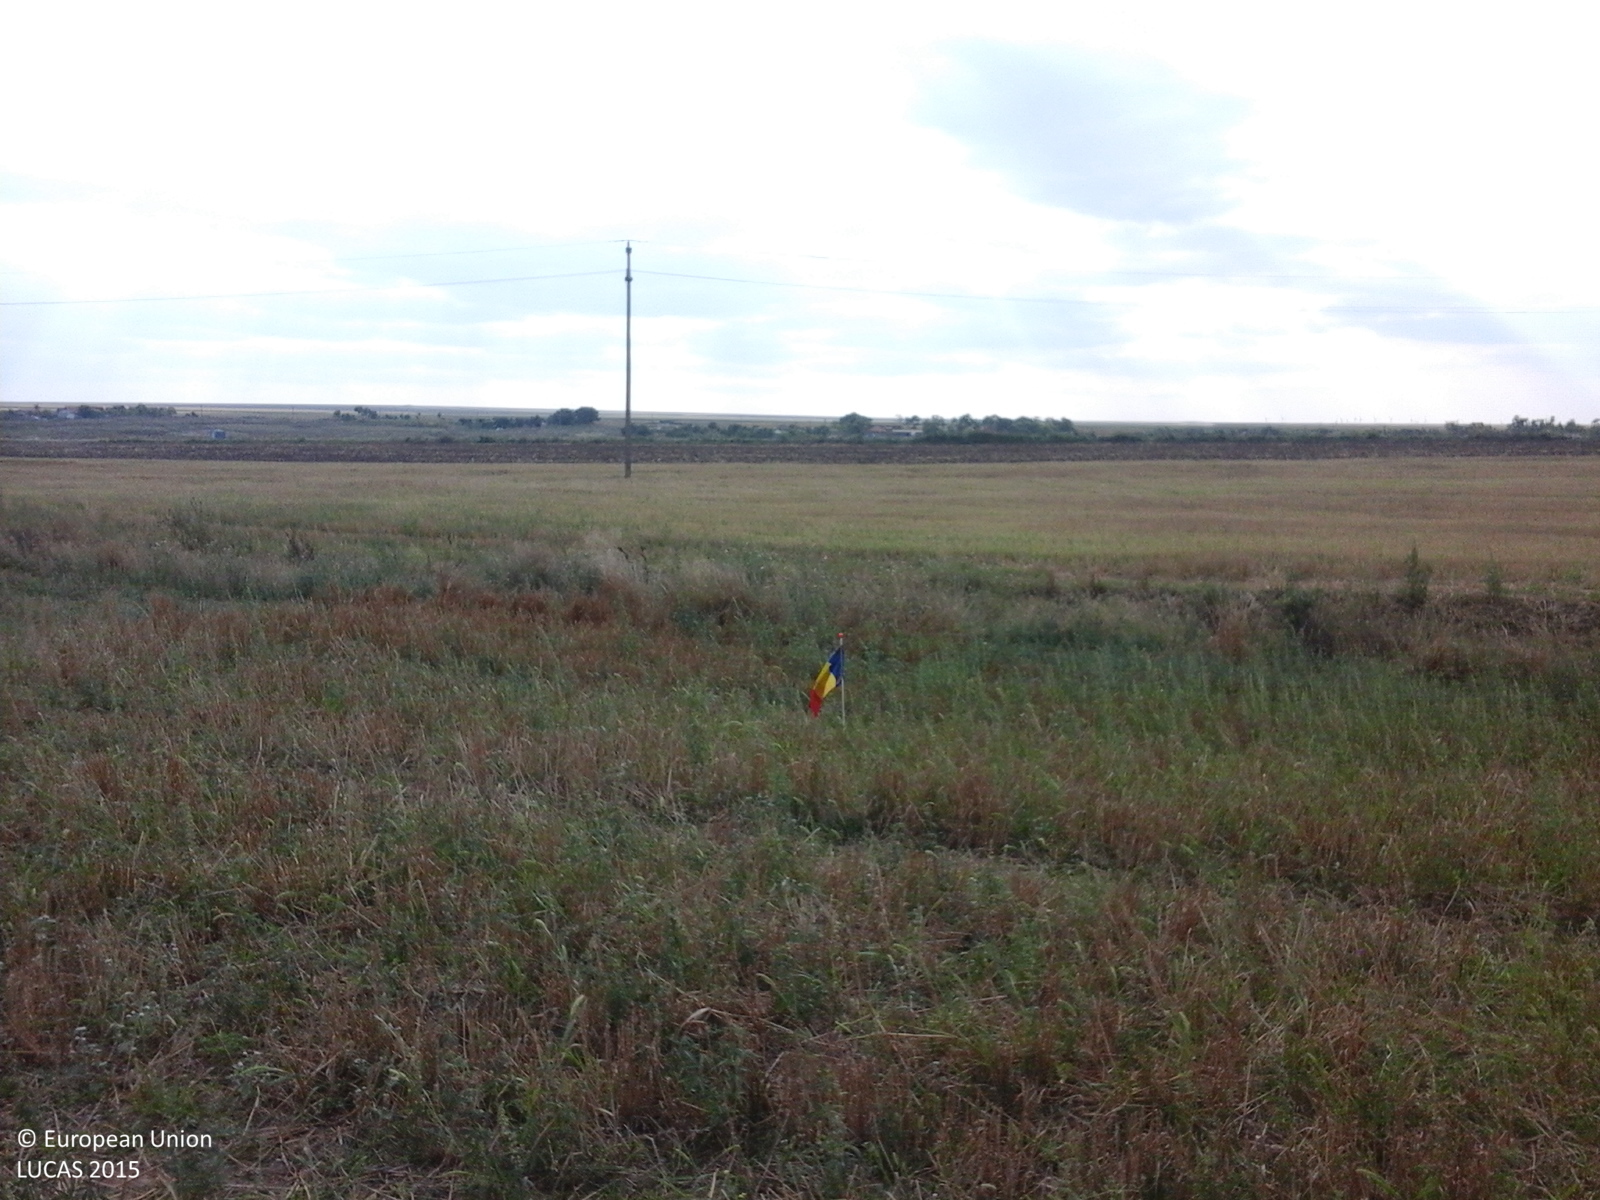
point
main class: Cropland
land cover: Triticale
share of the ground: > 75 %
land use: Agriculture (excluding fallow land and kitchen gardens)
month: August
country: RO
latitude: 44.6503
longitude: 28.4709
